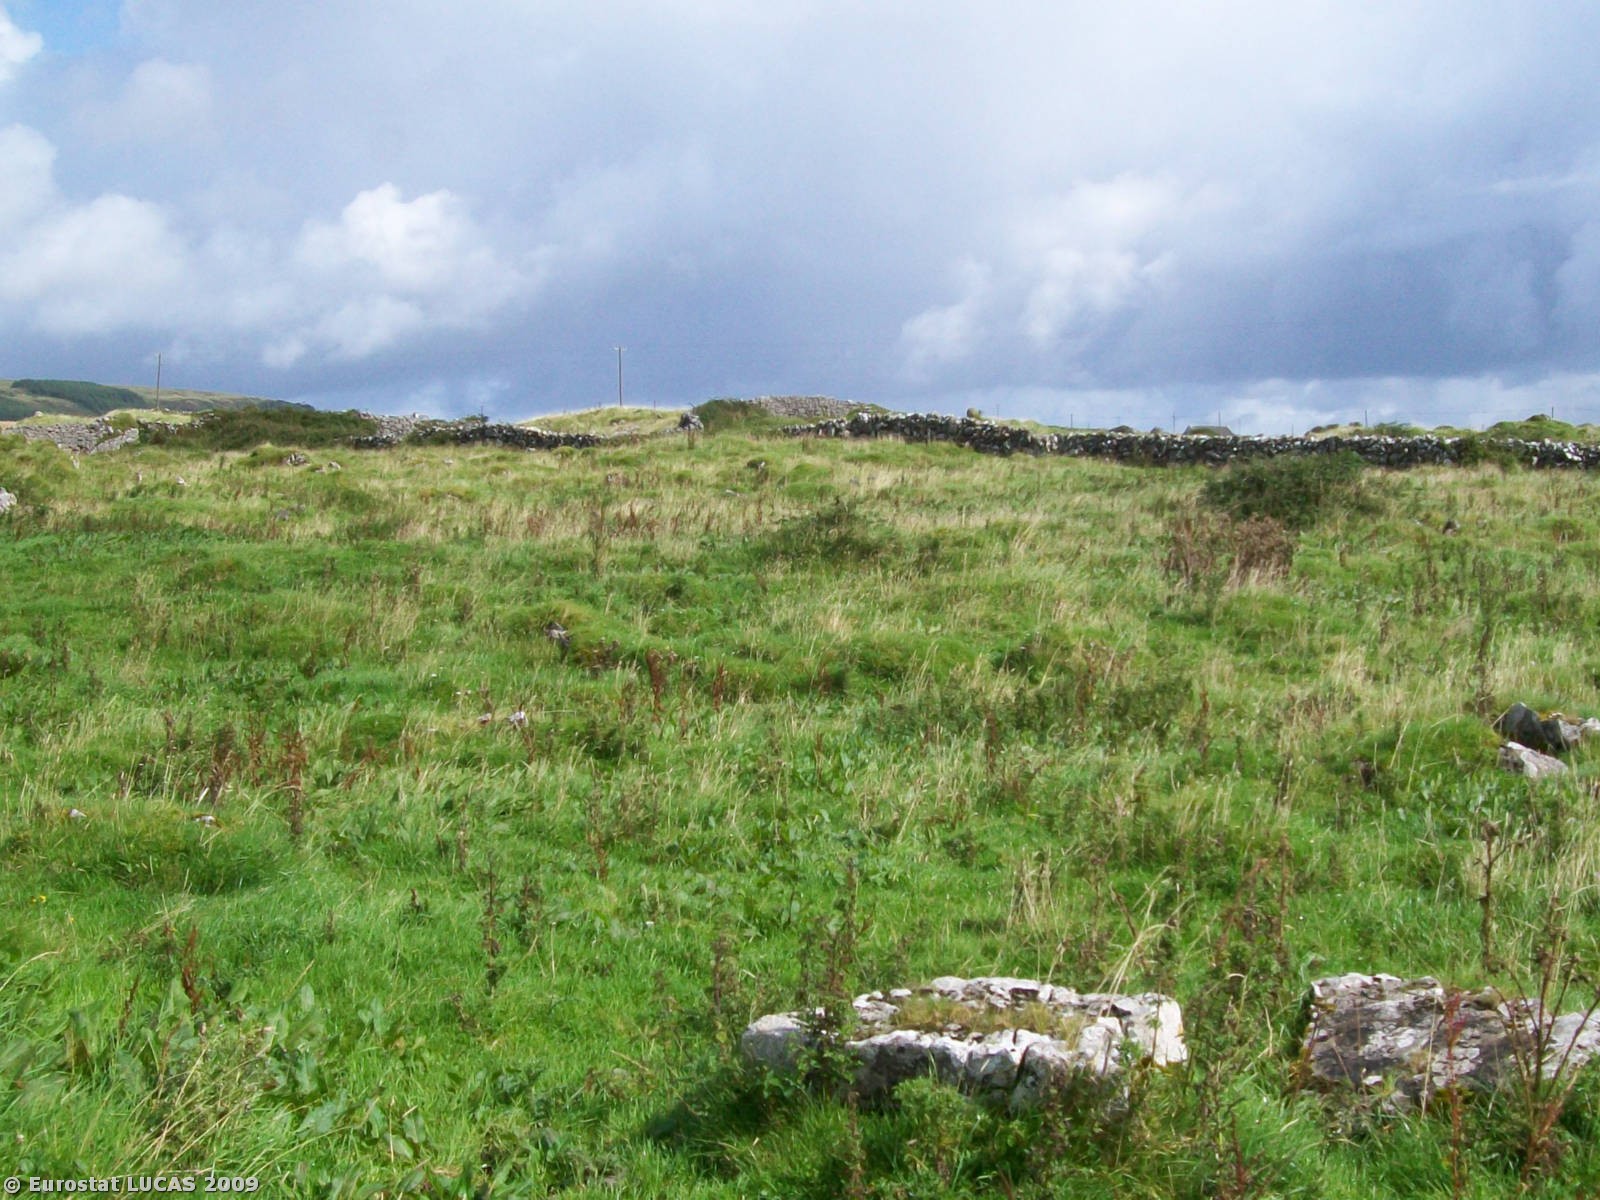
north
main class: Grassland
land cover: Grassland without tree/shrub cover
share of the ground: > 75 %
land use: Agriculture (excluding fallow land and kitchen gardens)
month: August
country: IE
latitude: 53.0361
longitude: -9.2674
